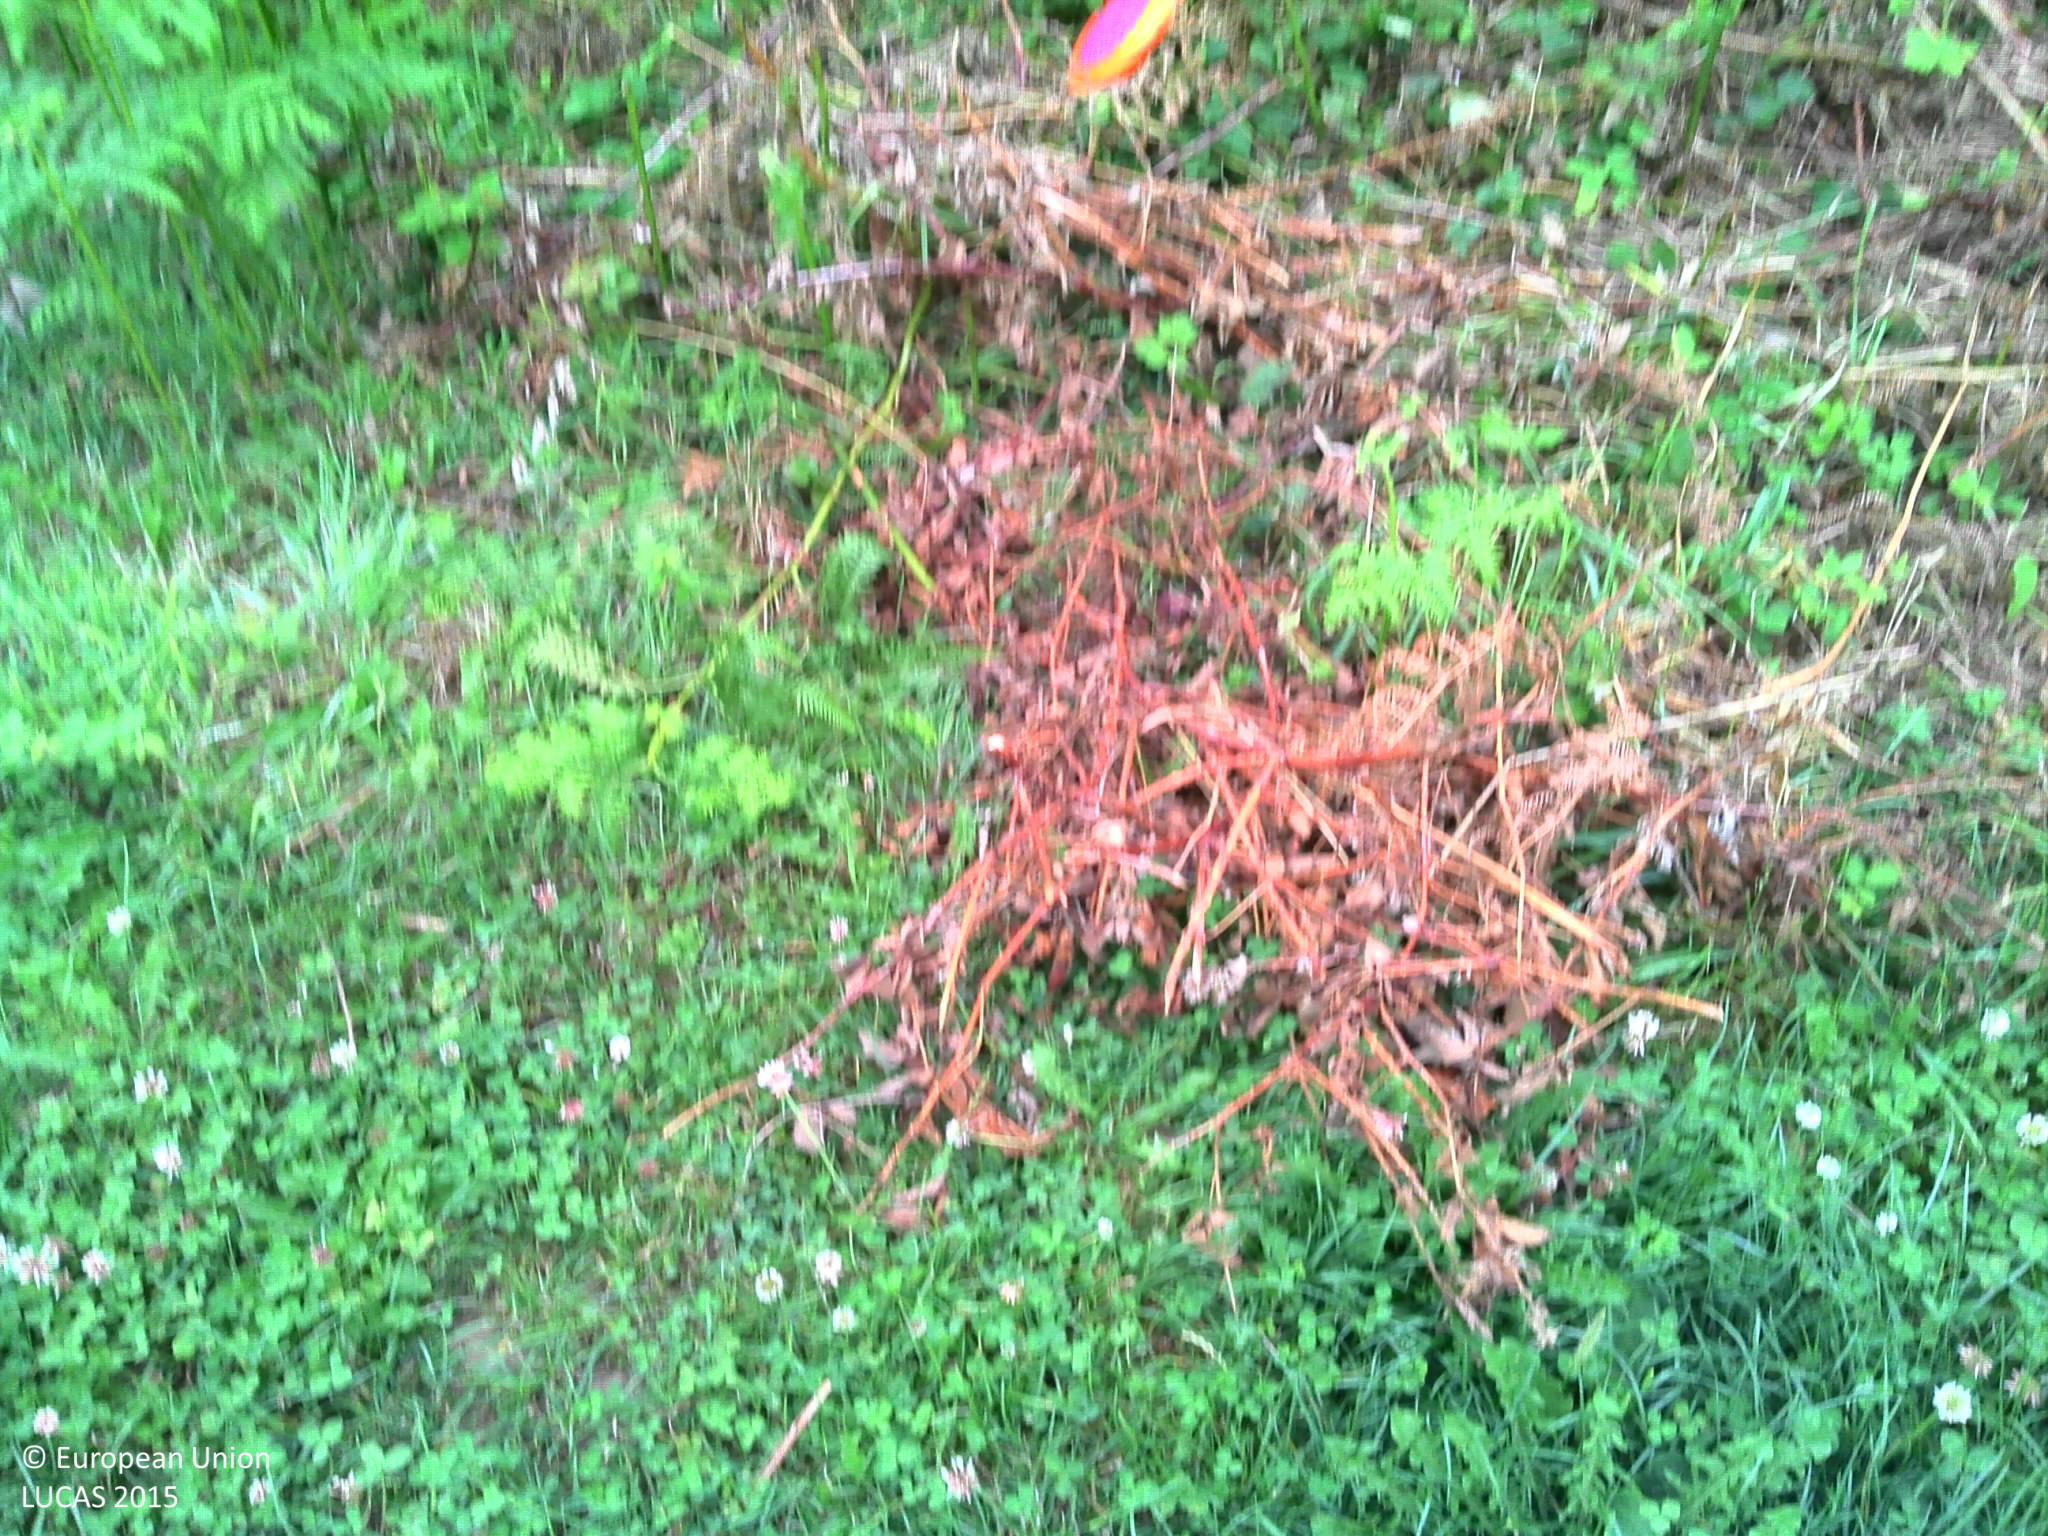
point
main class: Grassland
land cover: Grassland without tree/shrub cover
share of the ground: > 75 %
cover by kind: herbaceous plants 100 %
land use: Agriculture (excluding fallow land and kitchen gardens)
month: July
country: FR
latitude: 48.1196
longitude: -3.6343
